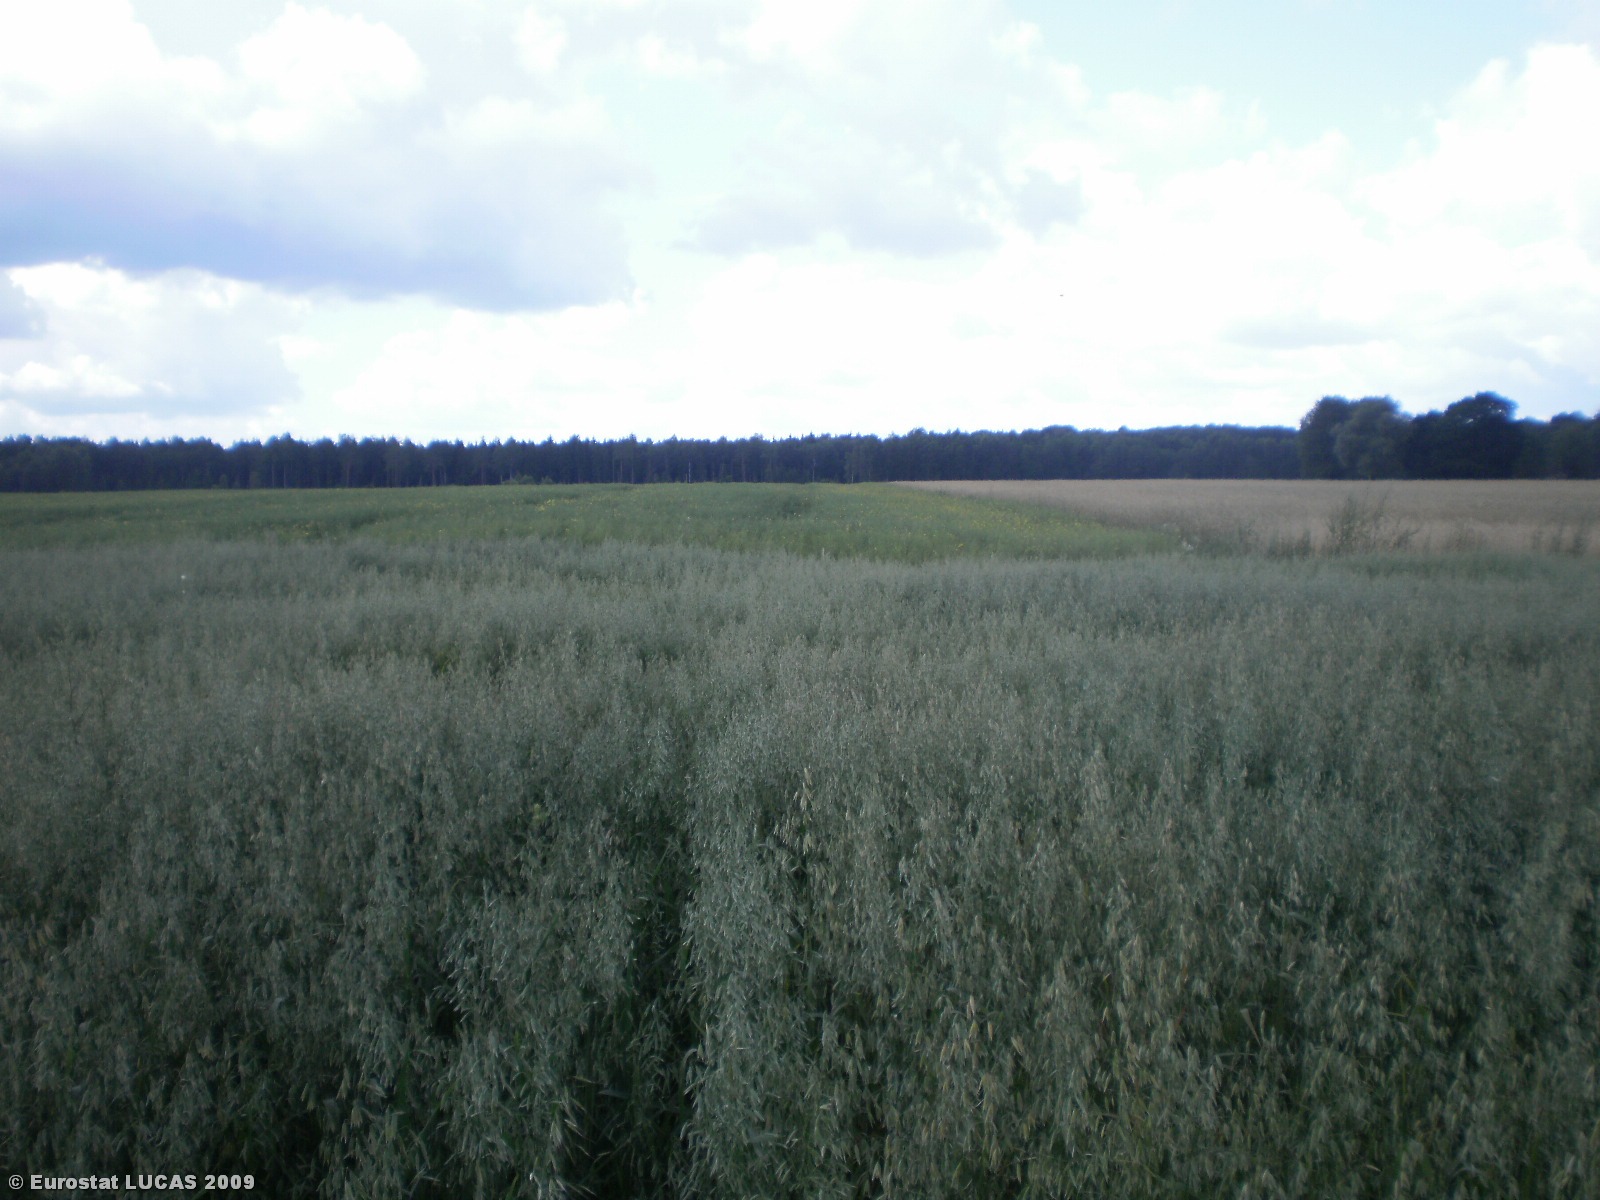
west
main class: Cropland
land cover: Oats
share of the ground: > 75 %
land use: Agriculture (excluding fallow land and kitchen gardens)
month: July
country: LT
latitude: 56.0885
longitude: 25.1398
